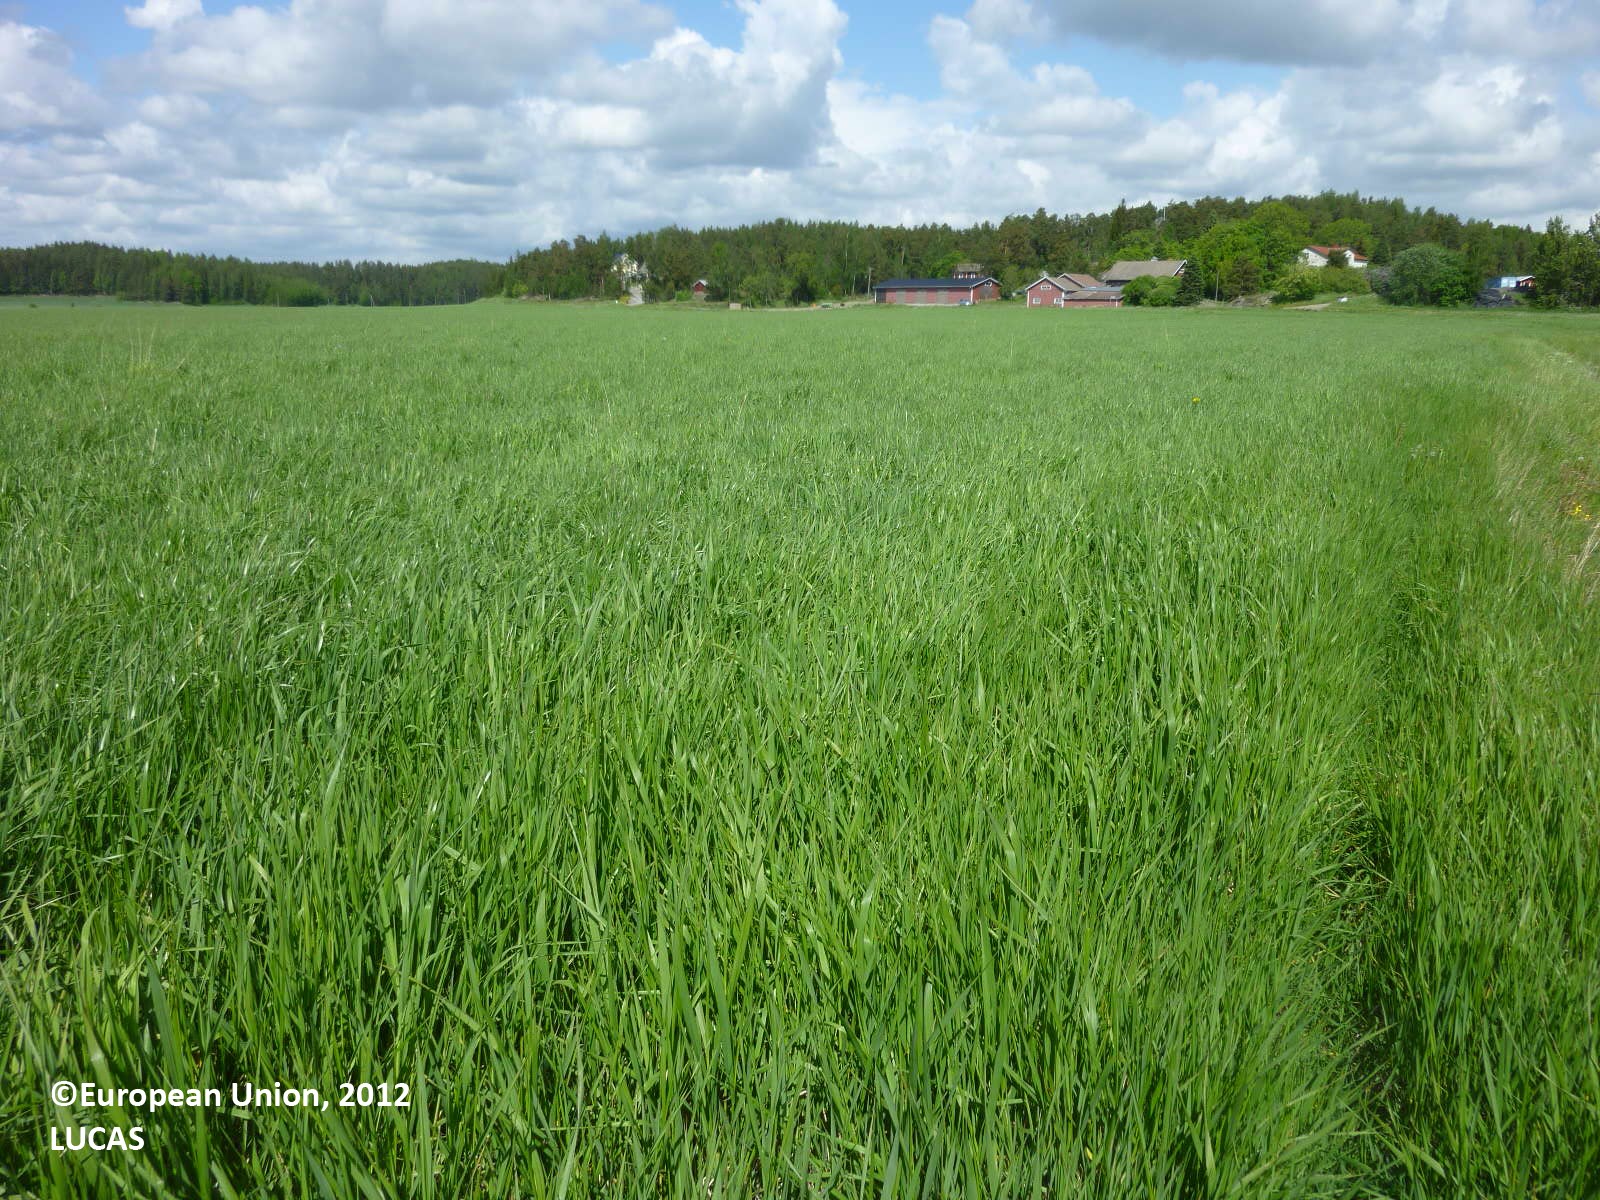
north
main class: Cropland
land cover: Temporary grasslands
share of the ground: > 75 %
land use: Agriculture (excluding fallow land and kitchen gardens)
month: June
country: FI
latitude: 60.3890
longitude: 22.4992
